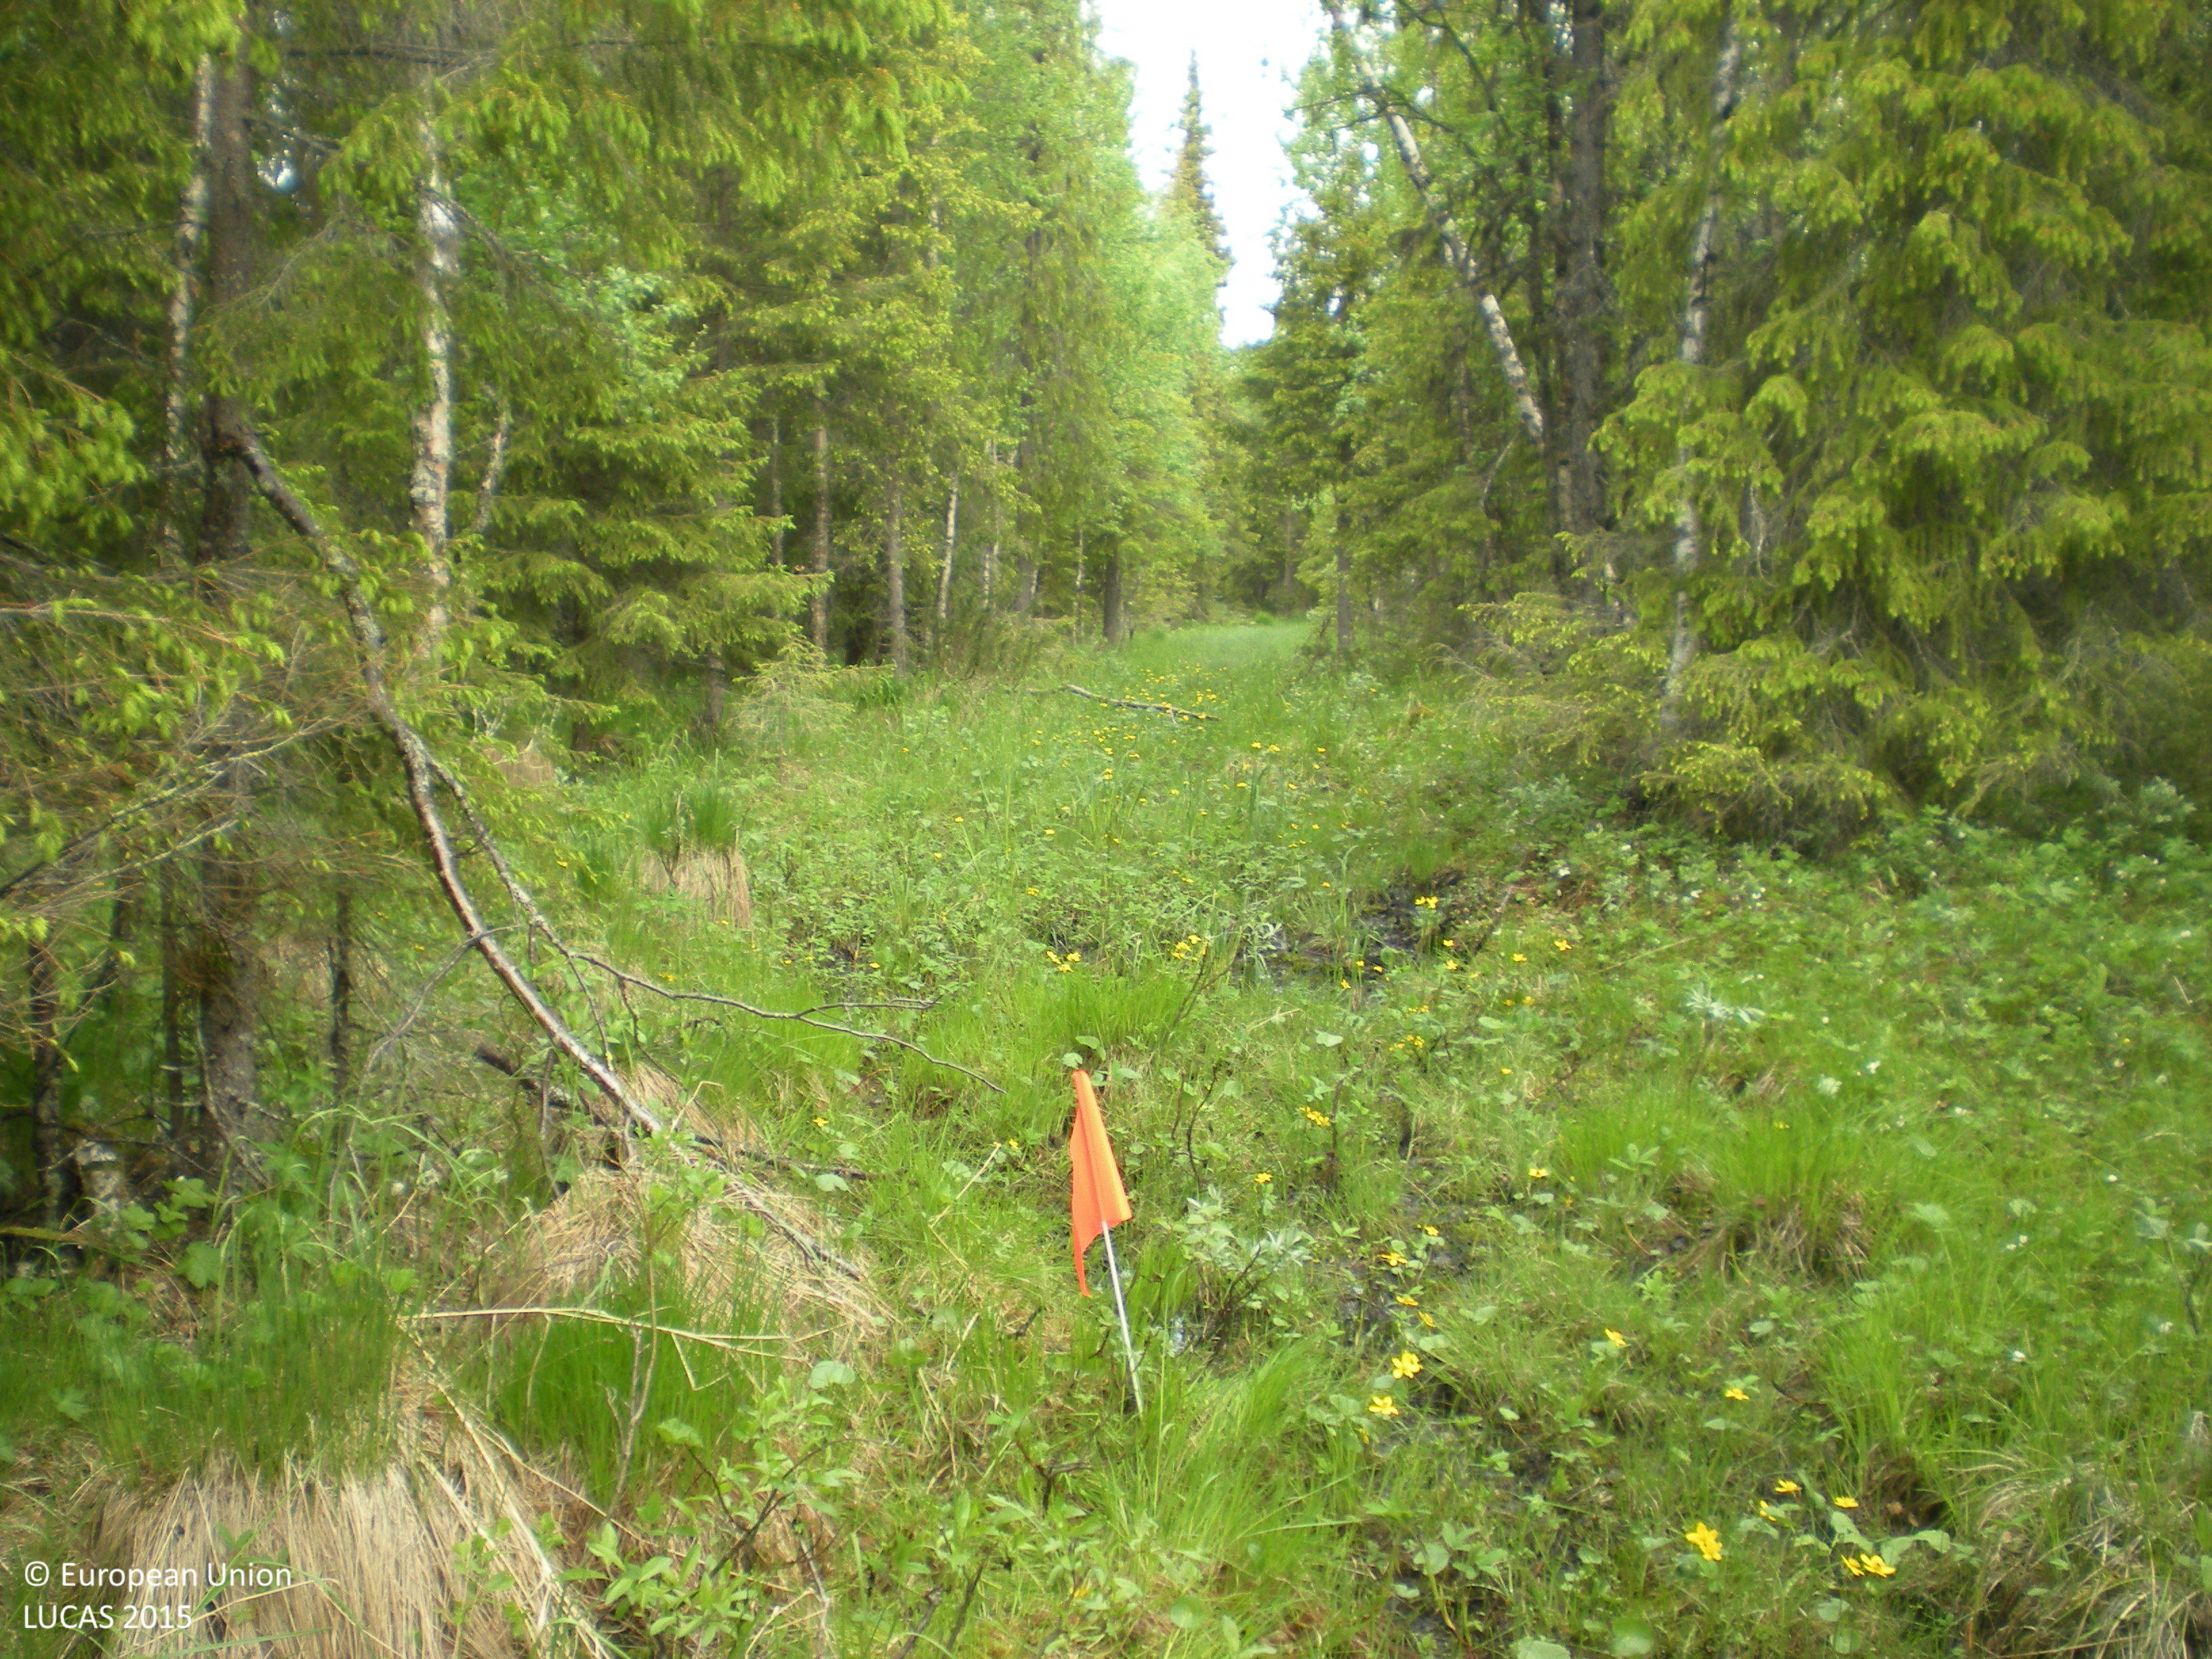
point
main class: Woodland
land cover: Spruce dominated mixed woodland
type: boreal forest
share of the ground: 50 - 75 %
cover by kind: coniferous forest trees 50 %, broadleaved forest trees 20 %, shrubs 15 %, herbaceous plants 10 %, lichens and mosses 5 %
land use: Forestry
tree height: > 5 m
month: July
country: SE
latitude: 66.0874
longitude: 17.1854
